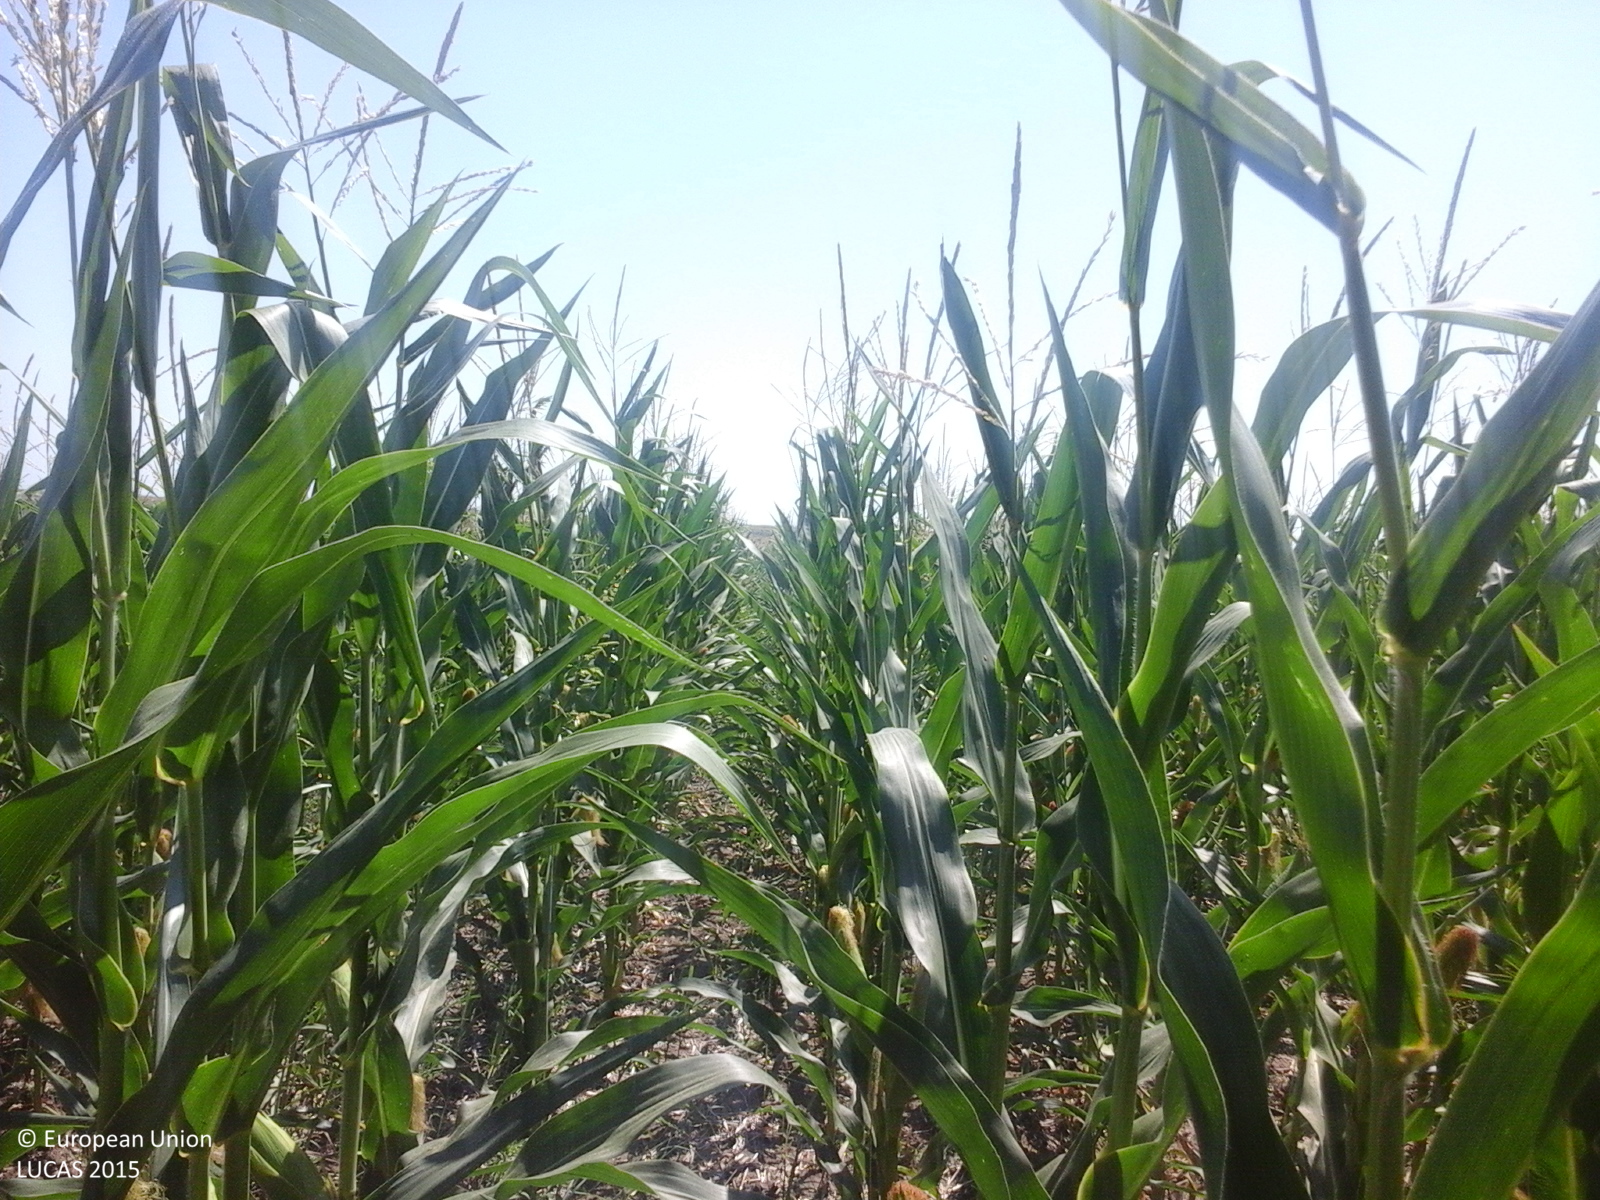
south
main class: Cropland
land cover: Maize
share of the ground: > 75 %
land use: Agriculture (excluding fallow land and kitchen gardens)
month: July
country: RO
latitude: 44.2252
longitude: 26.6534
